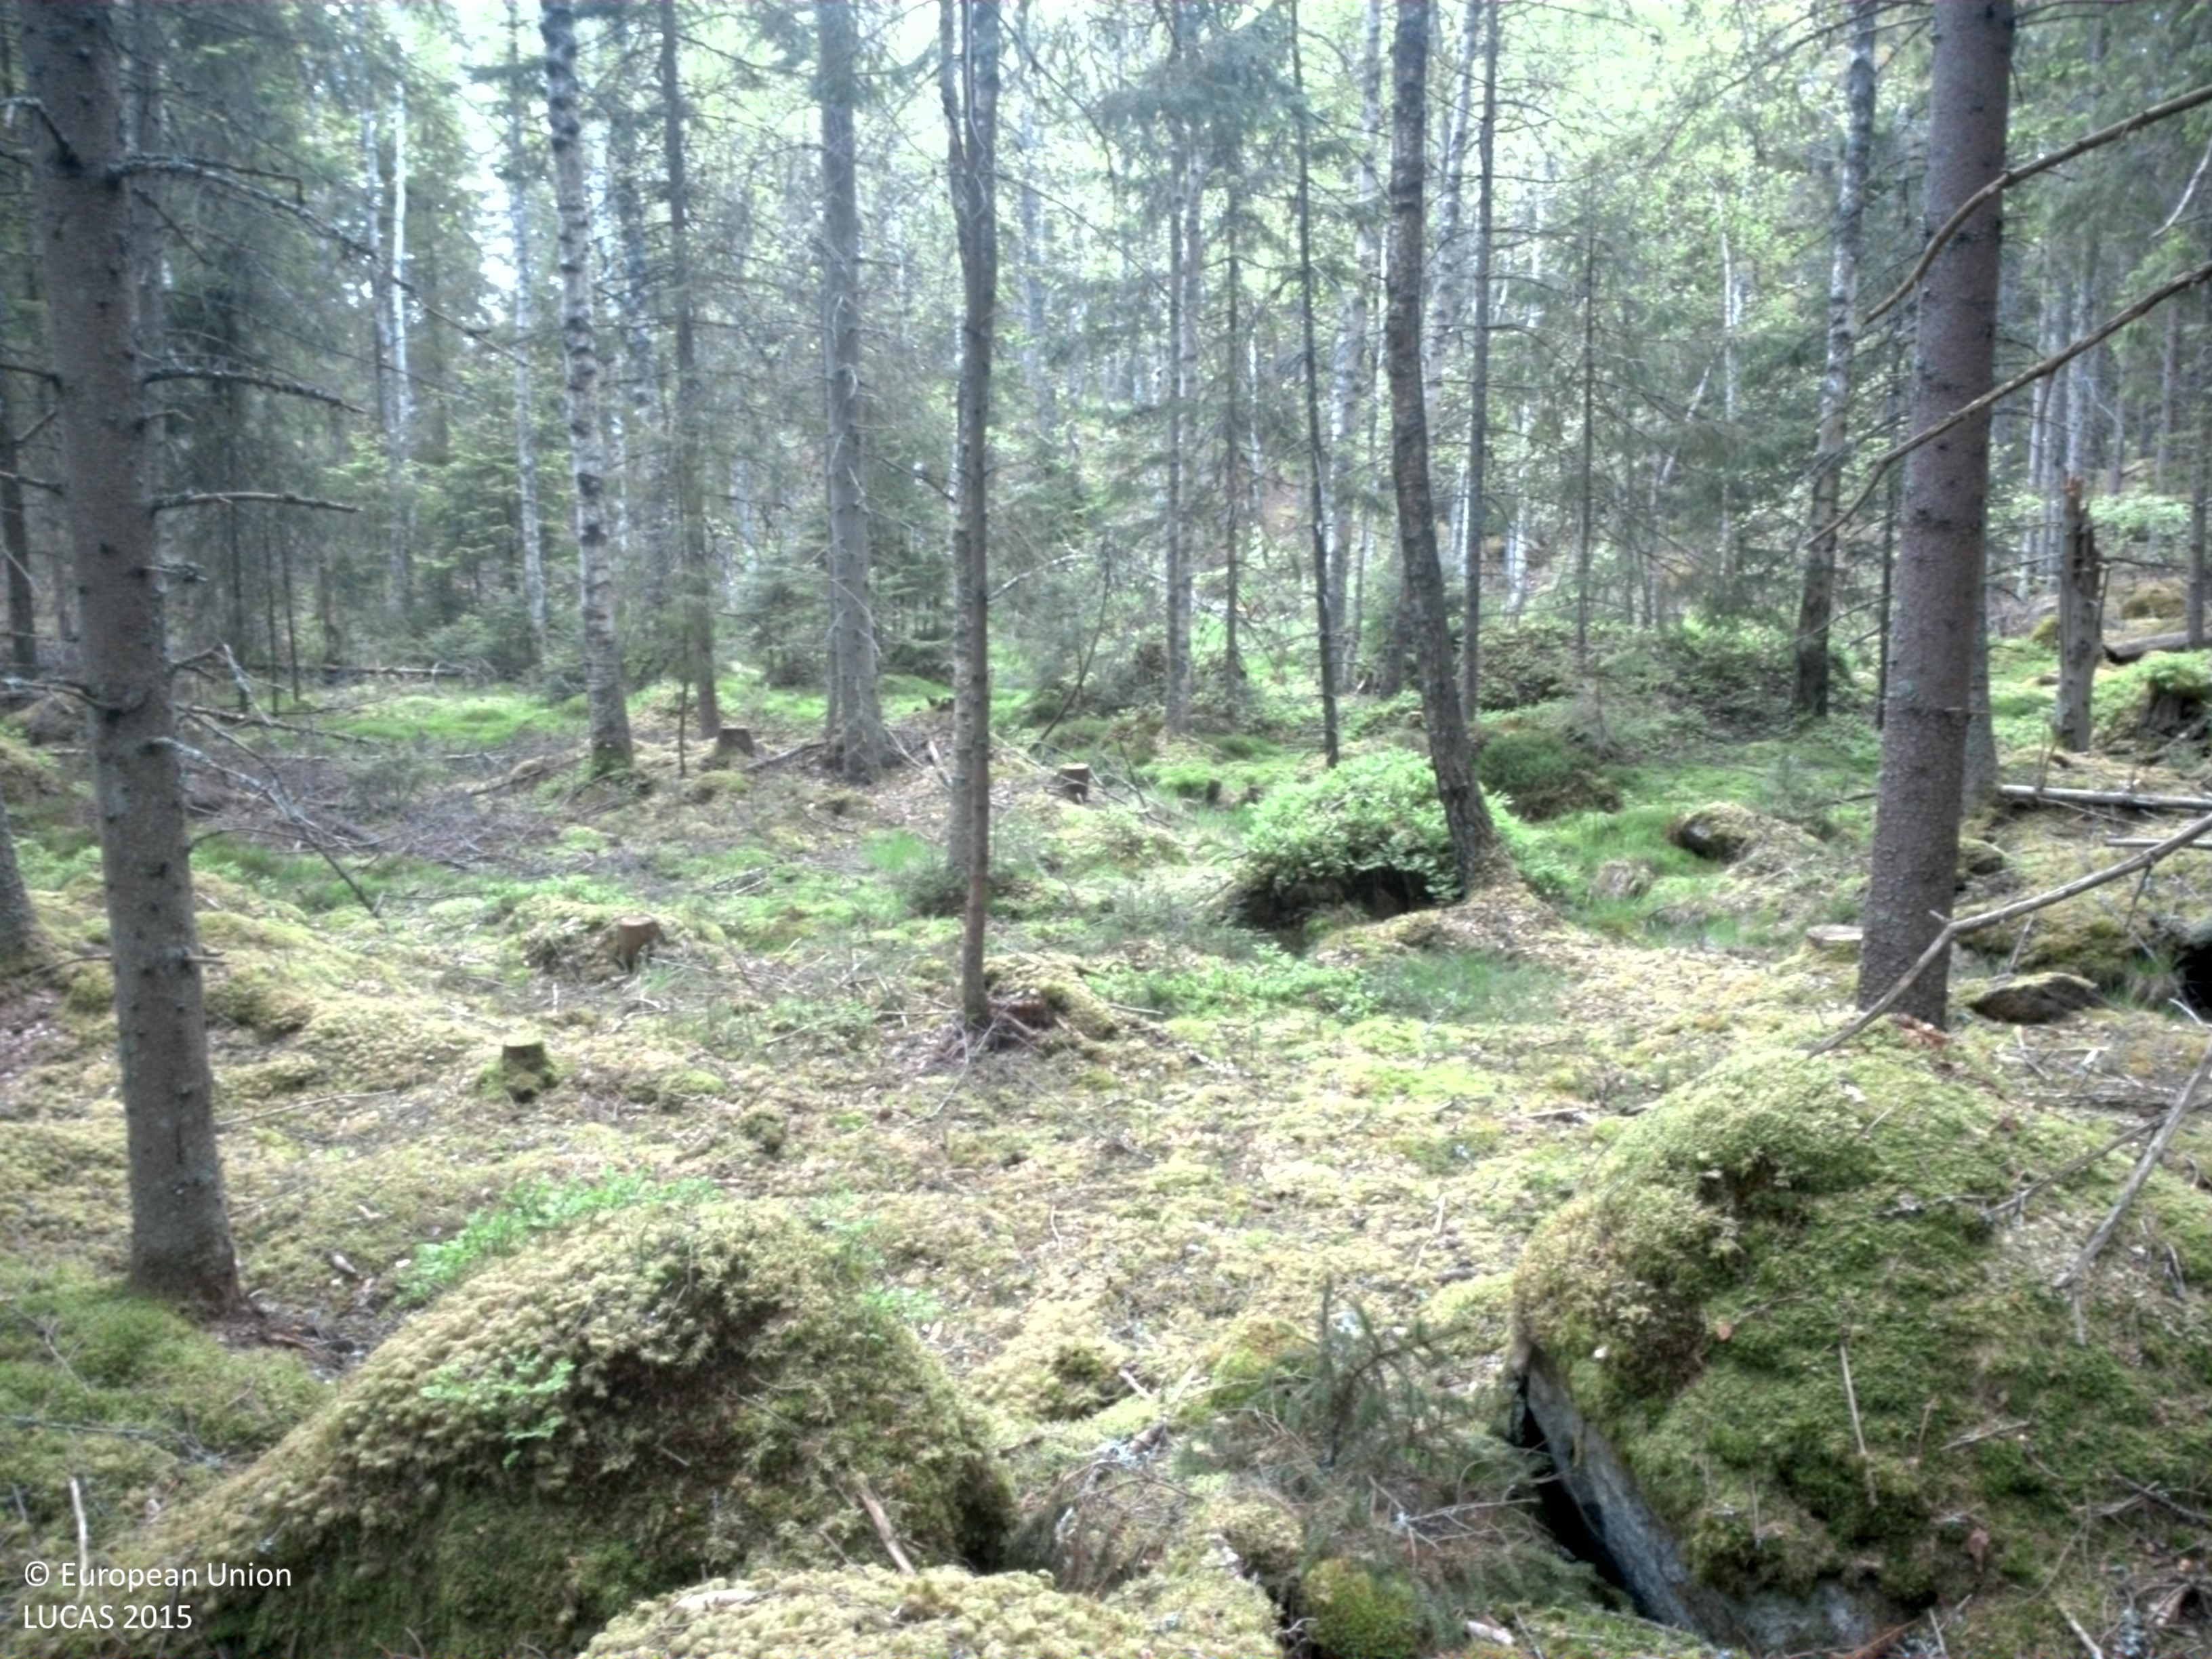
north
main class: Woodland
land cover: Spruce dominated coniferous woodland
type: boreal forest
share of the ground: > 75 %
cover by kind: coniferous forest trees 85 %, lichens and mosses 10 %, broadleaved forest trees 5 %
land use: Forestry
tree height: > 5 m
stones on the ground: < 10 %
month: May
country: SE
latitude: 56.5540
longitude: 15.1228
